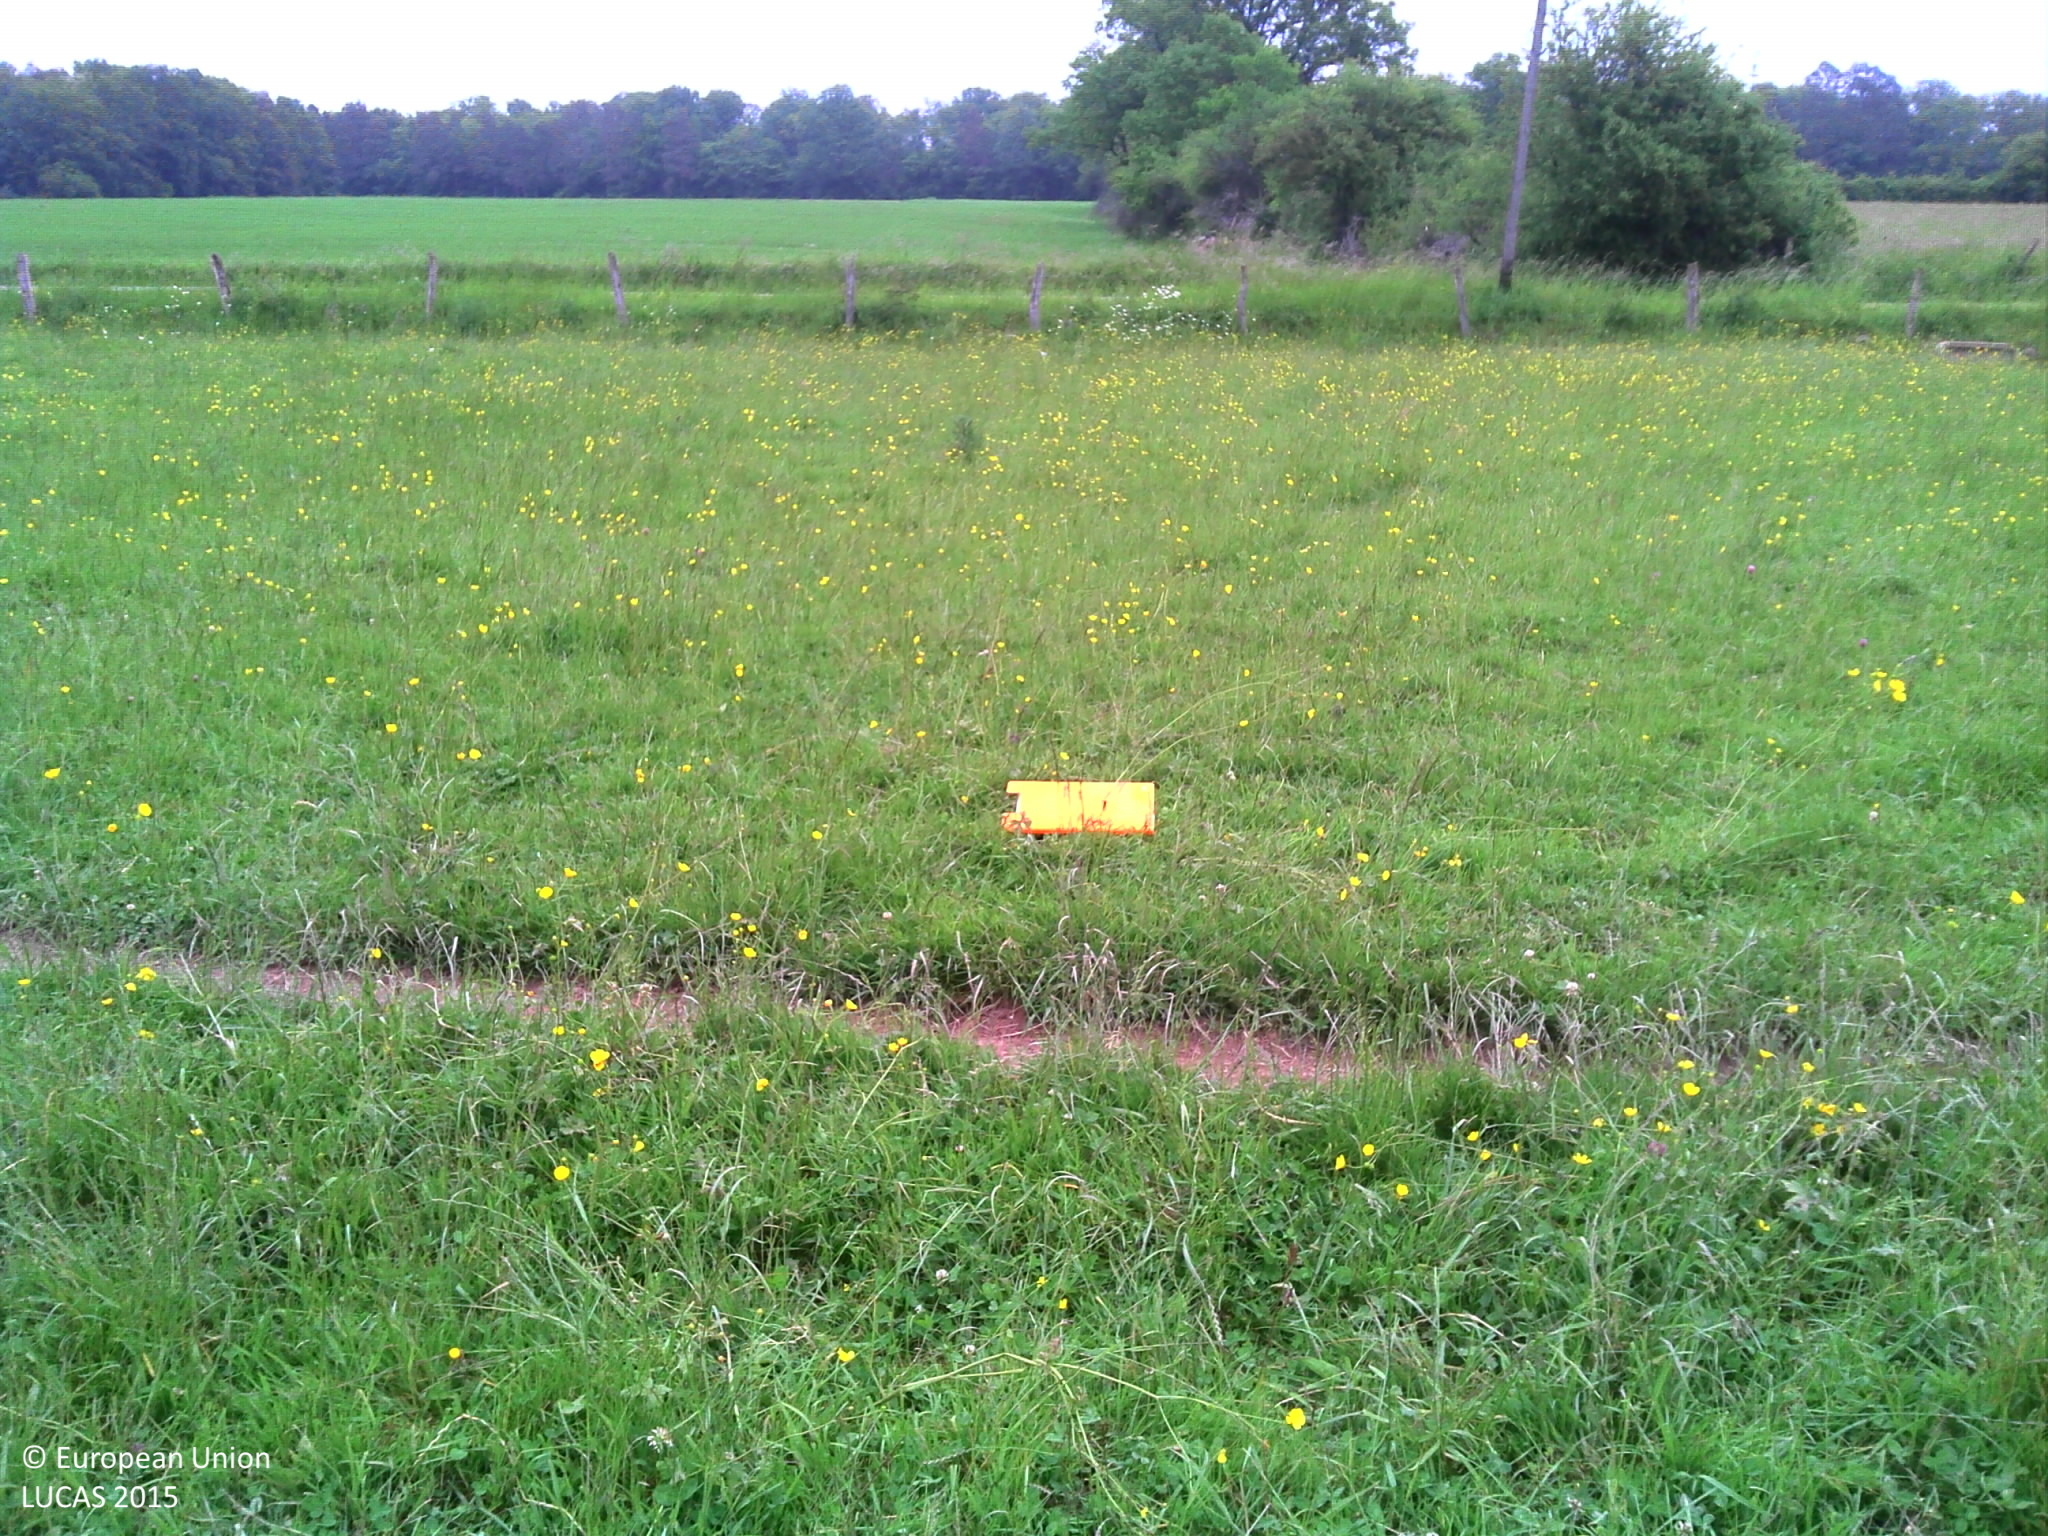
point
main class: Grassland
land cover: Grassland without tree/shrub cover
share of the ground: > 75 %
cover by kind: herbaceous plants 100 %
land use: Agriculture (excluding fallow land and kitchen gardens)
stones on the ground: < 10 %
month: May
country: FR
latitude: 47.9064
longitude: 6.2148
